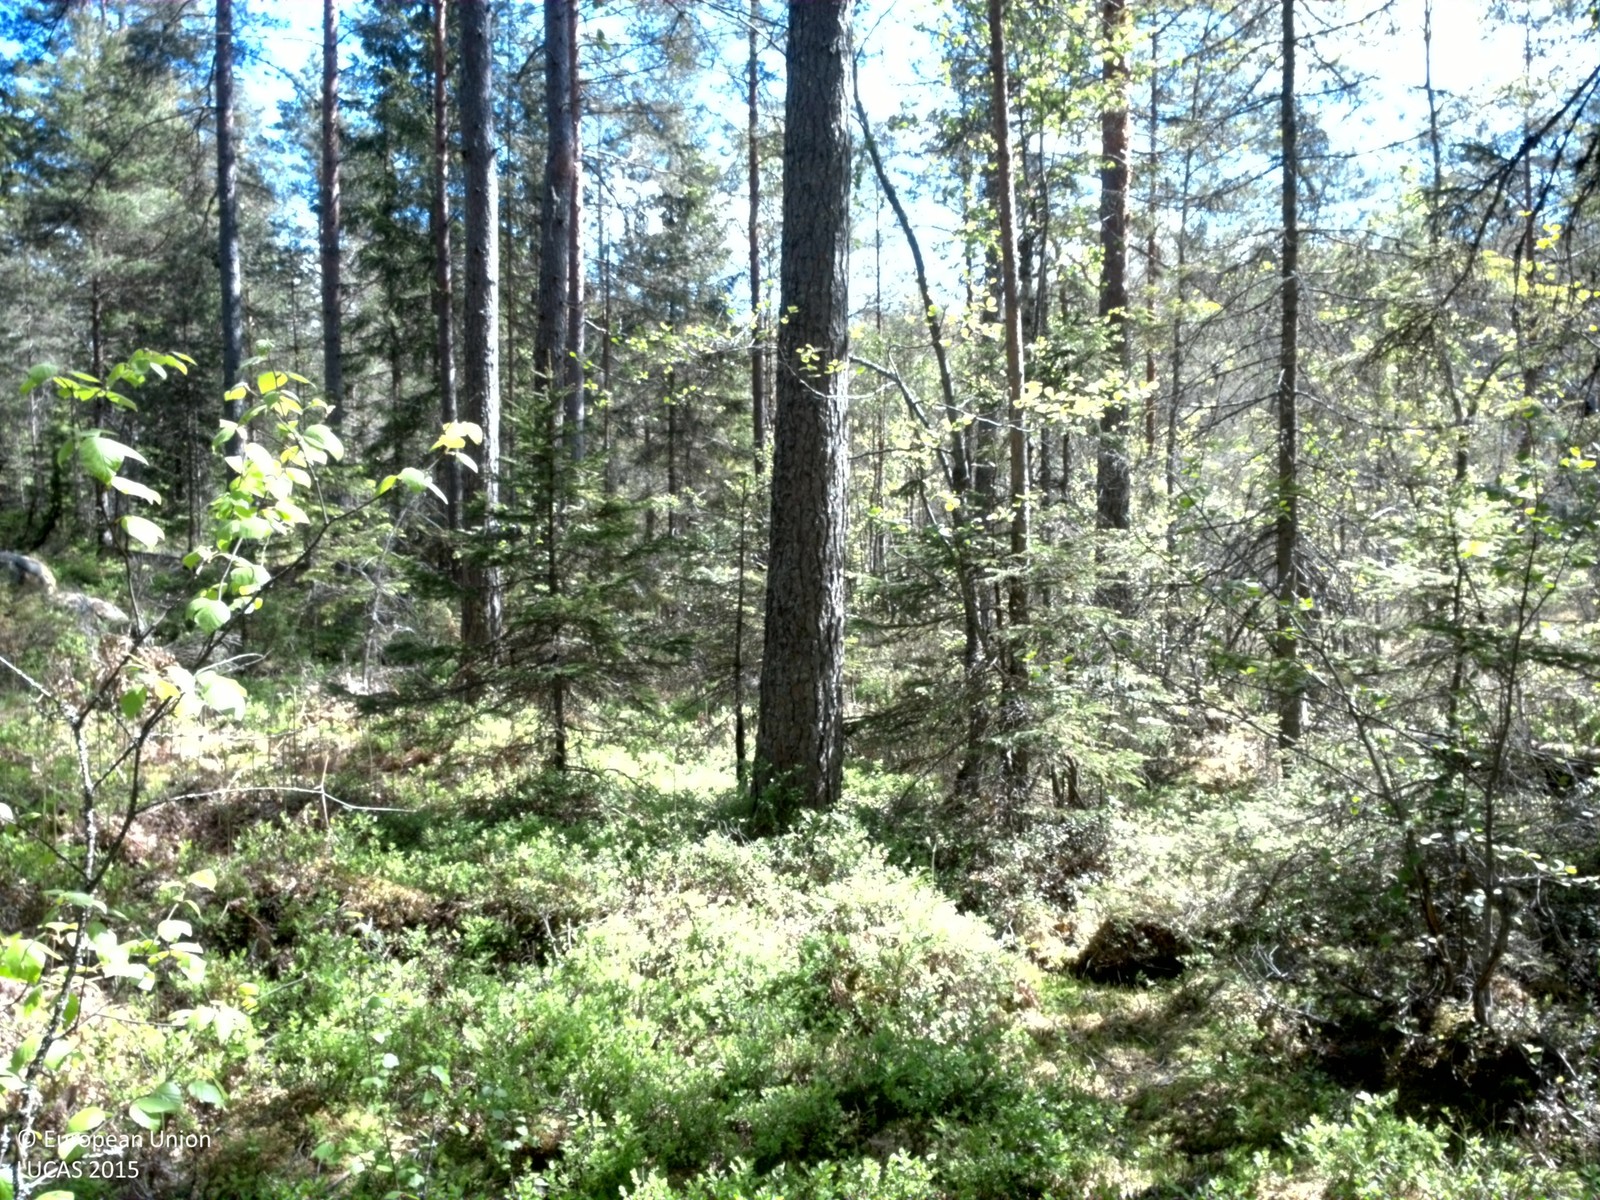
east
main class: Woodland
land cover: Pine dominated coniferous woodland
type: boreal forest
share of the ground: 25 - 50 %
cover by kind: coniferous forest trees 40 %, shrubs 30 %, broadleaved forest trees 10 %, herbaceous plants 10 %, lichens and mosses 10 %
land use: Forestry
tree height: > 5 m
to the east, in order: Pine dominated coniferous woodland; Peatbogs; Pine dominated coniferous woodland
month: May
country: SE
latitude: 57.3685
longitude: 15.9007
